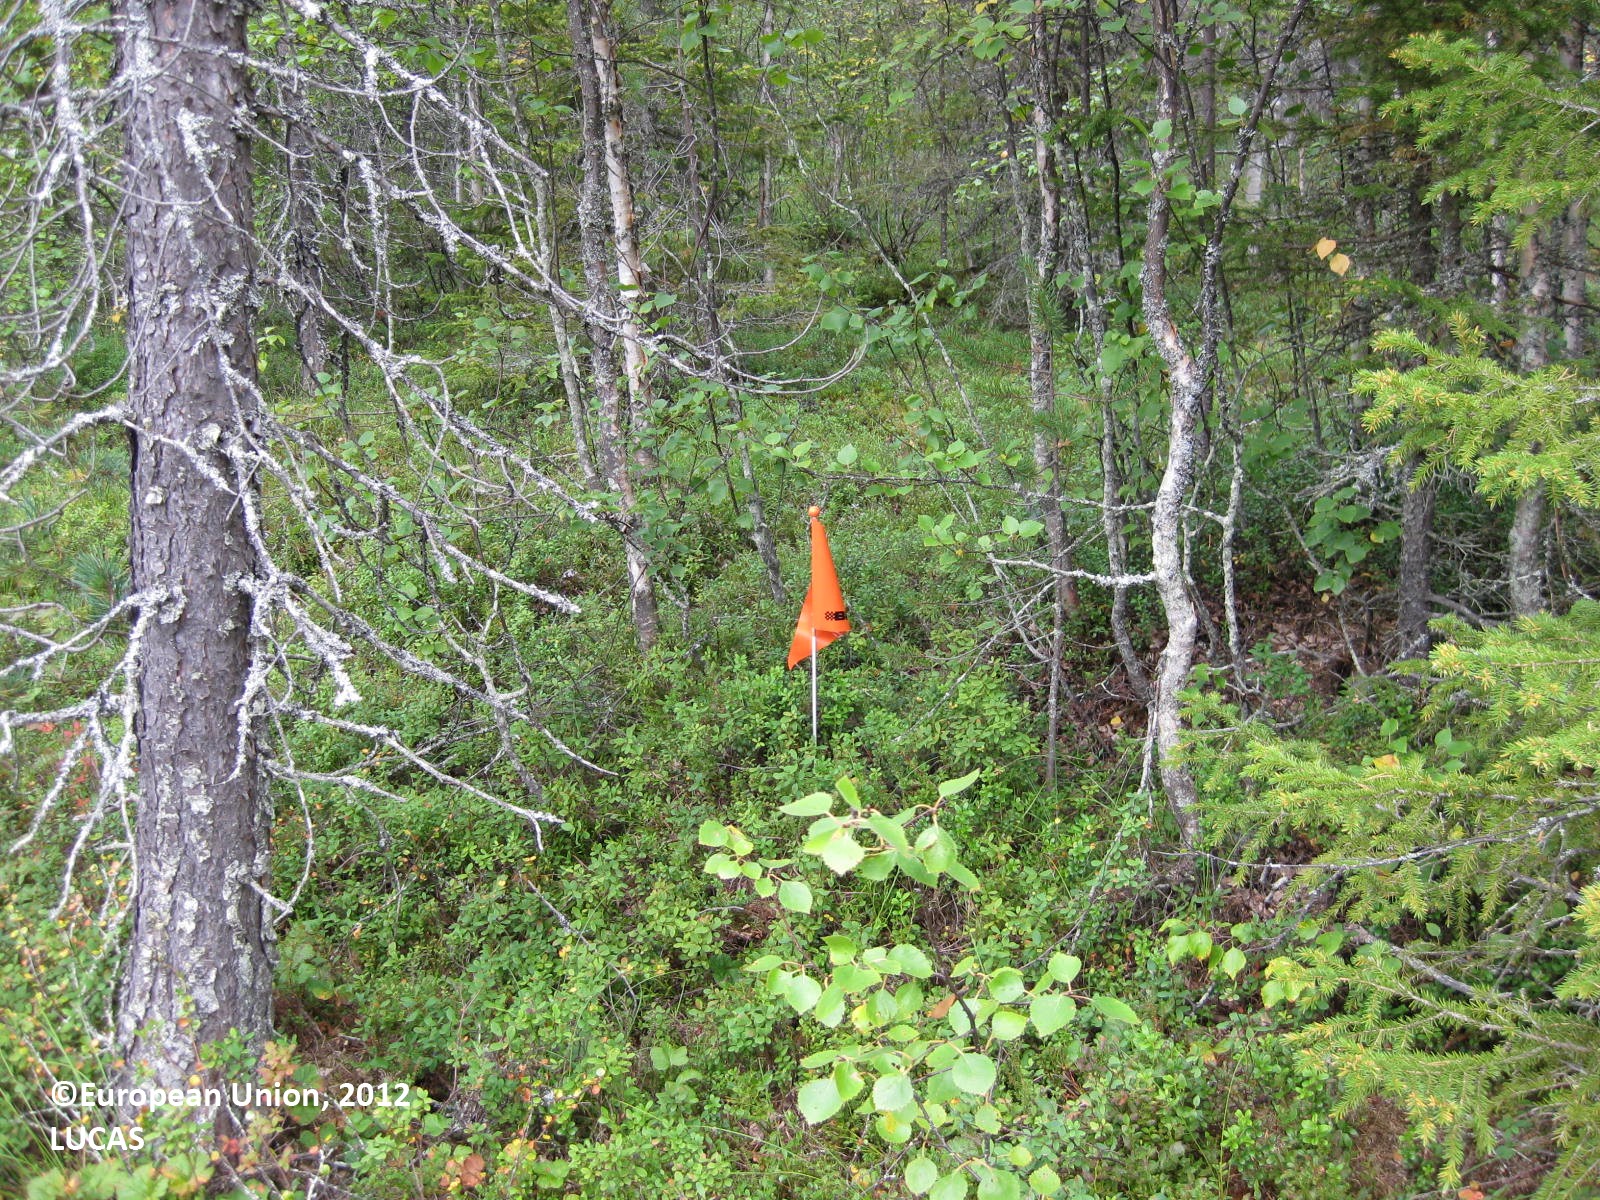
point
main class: Woodland
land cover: Pine dominated mixed woodland
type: boreal forest
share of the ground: > 75 %
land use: Forestry
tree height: > 5 m
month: August
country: FI
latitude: 66.2542
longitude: 28.7871
